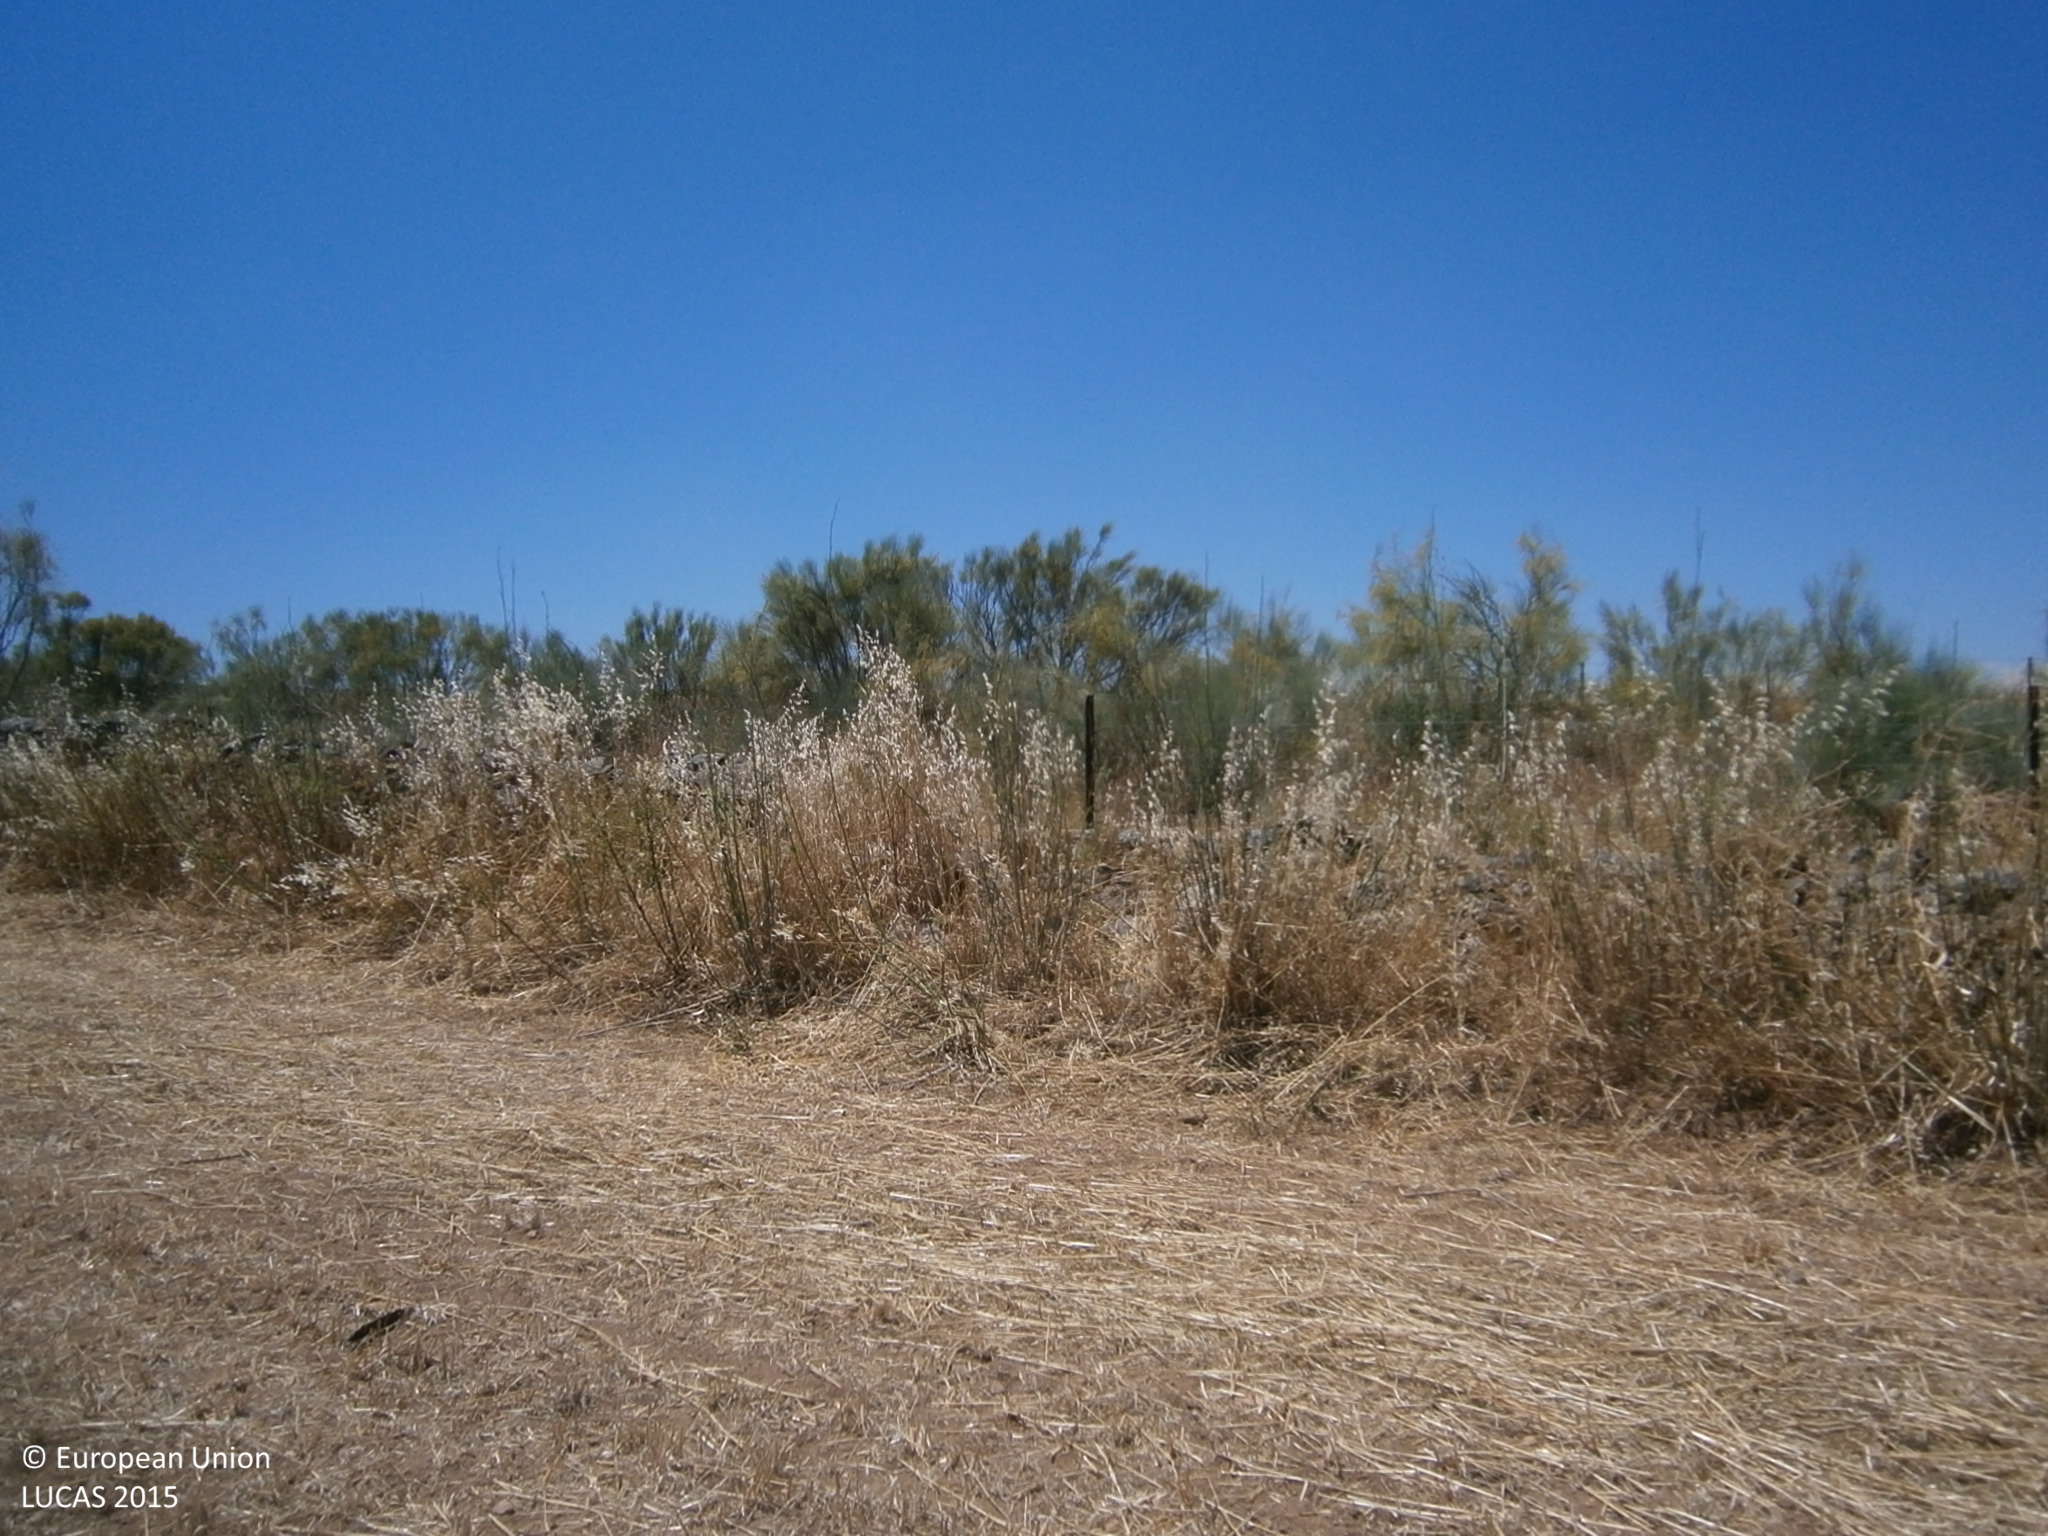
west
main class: Cropland
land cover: Mixed cereals for fodder
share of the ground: > 75 %
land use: Agriculture (excluding fallow land and kitchen gardens)
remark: Harvested field
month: June
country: ES
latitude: 38.6641
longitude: -6.8775
